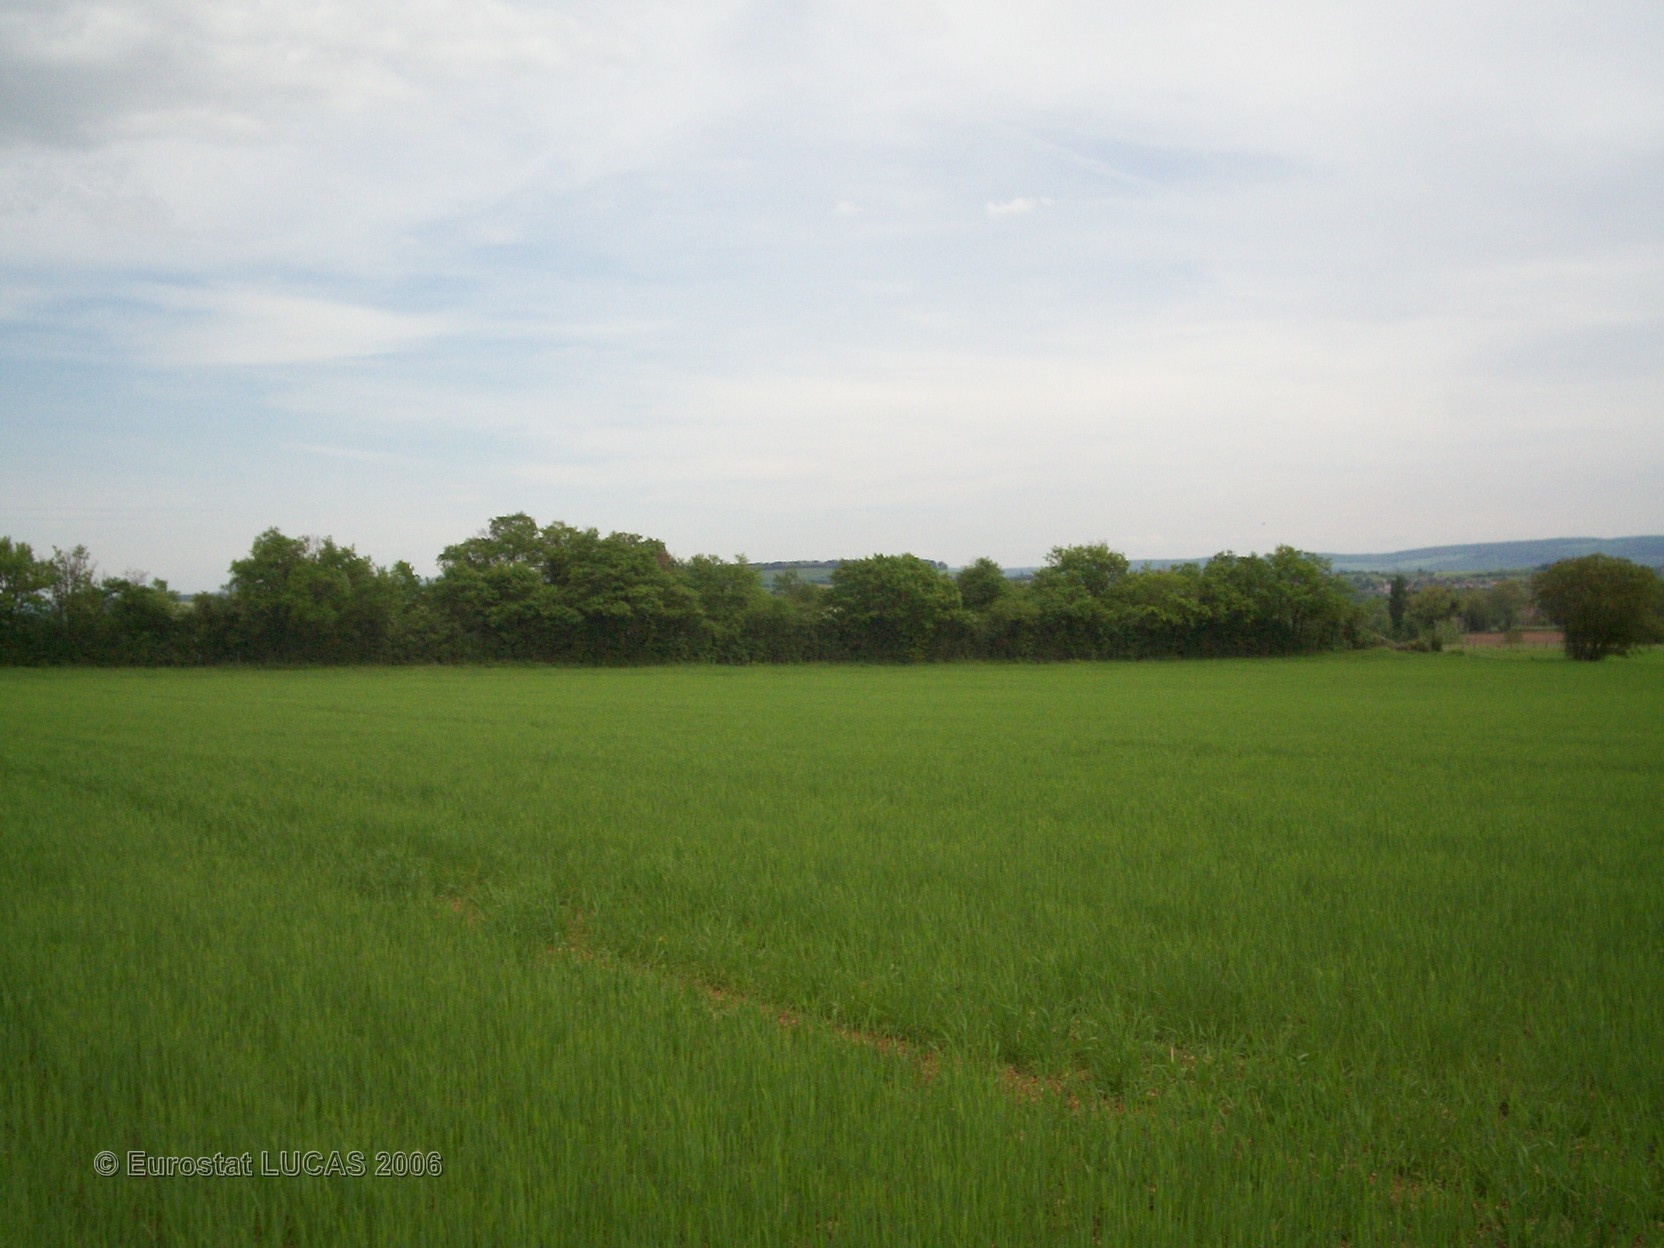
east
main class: Cropland
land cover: Barley
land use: Agriculture (excluding fallow land and kitchen gardens)
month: May
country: FR
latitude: 46.5598
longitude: 4.6401
